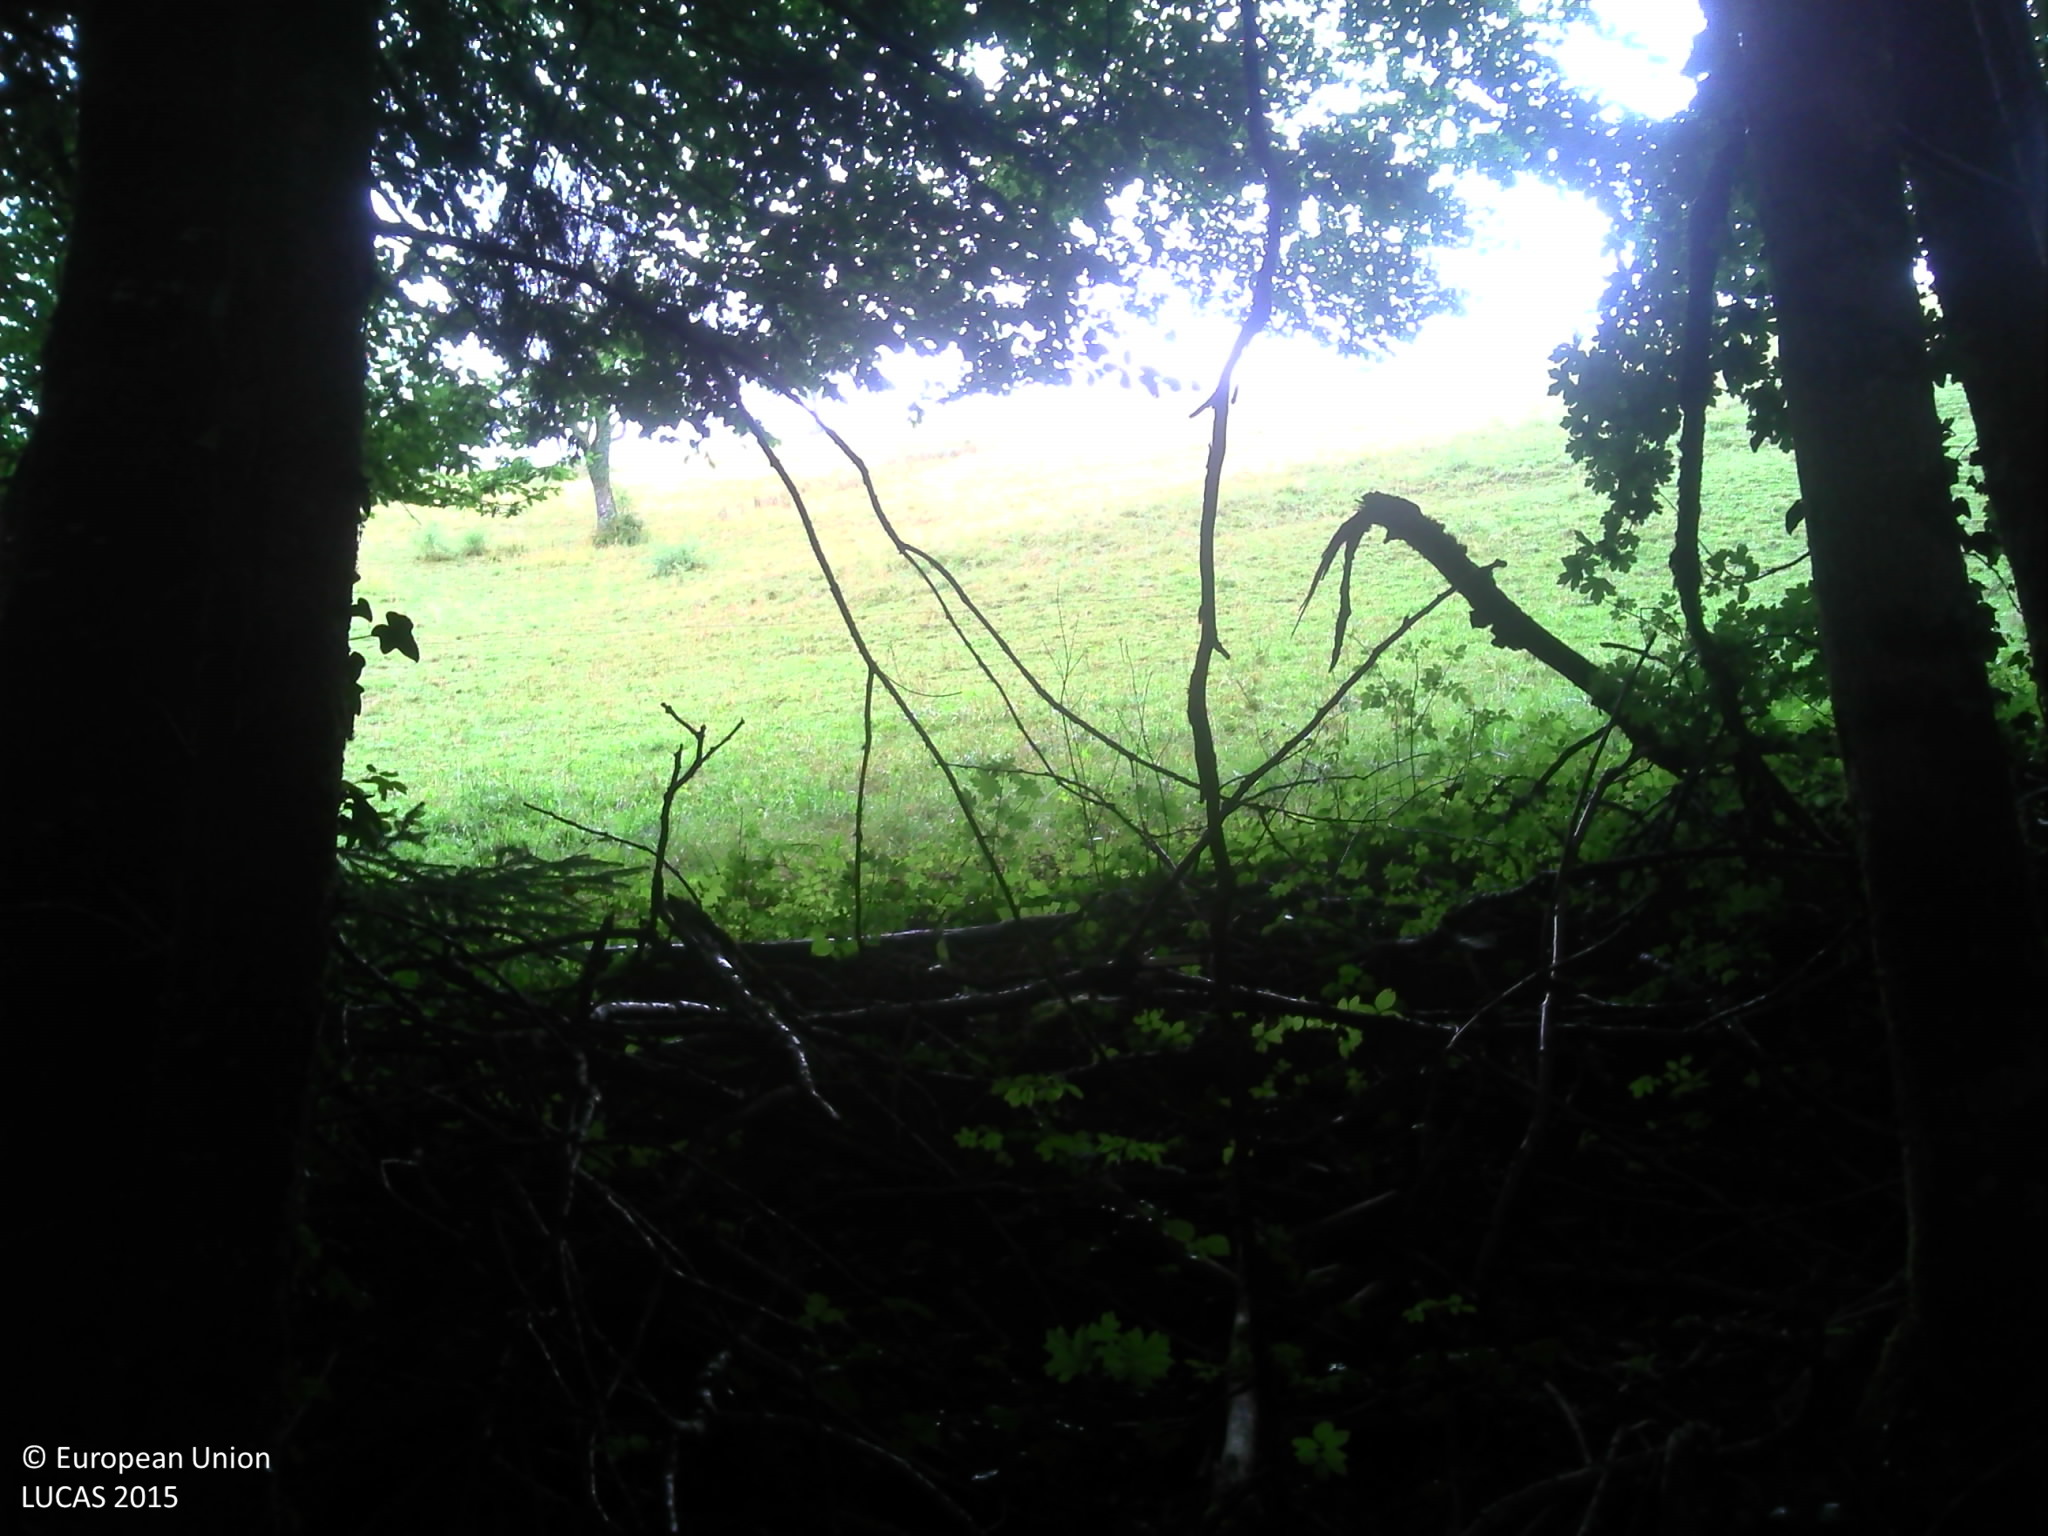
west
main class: Woodland
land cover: Broadleaved woodland
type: beech forest
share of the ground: > 75 %
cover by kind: broadleaved forest trees 65 %, coniferous forest trees 15 %, herbaceous plants 15 %, lichens and mosses 5 %
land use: Semi-natural and natural areas not in use
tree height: > 5 m
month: July
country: FR
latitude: 45.9770
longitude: 6.1963
